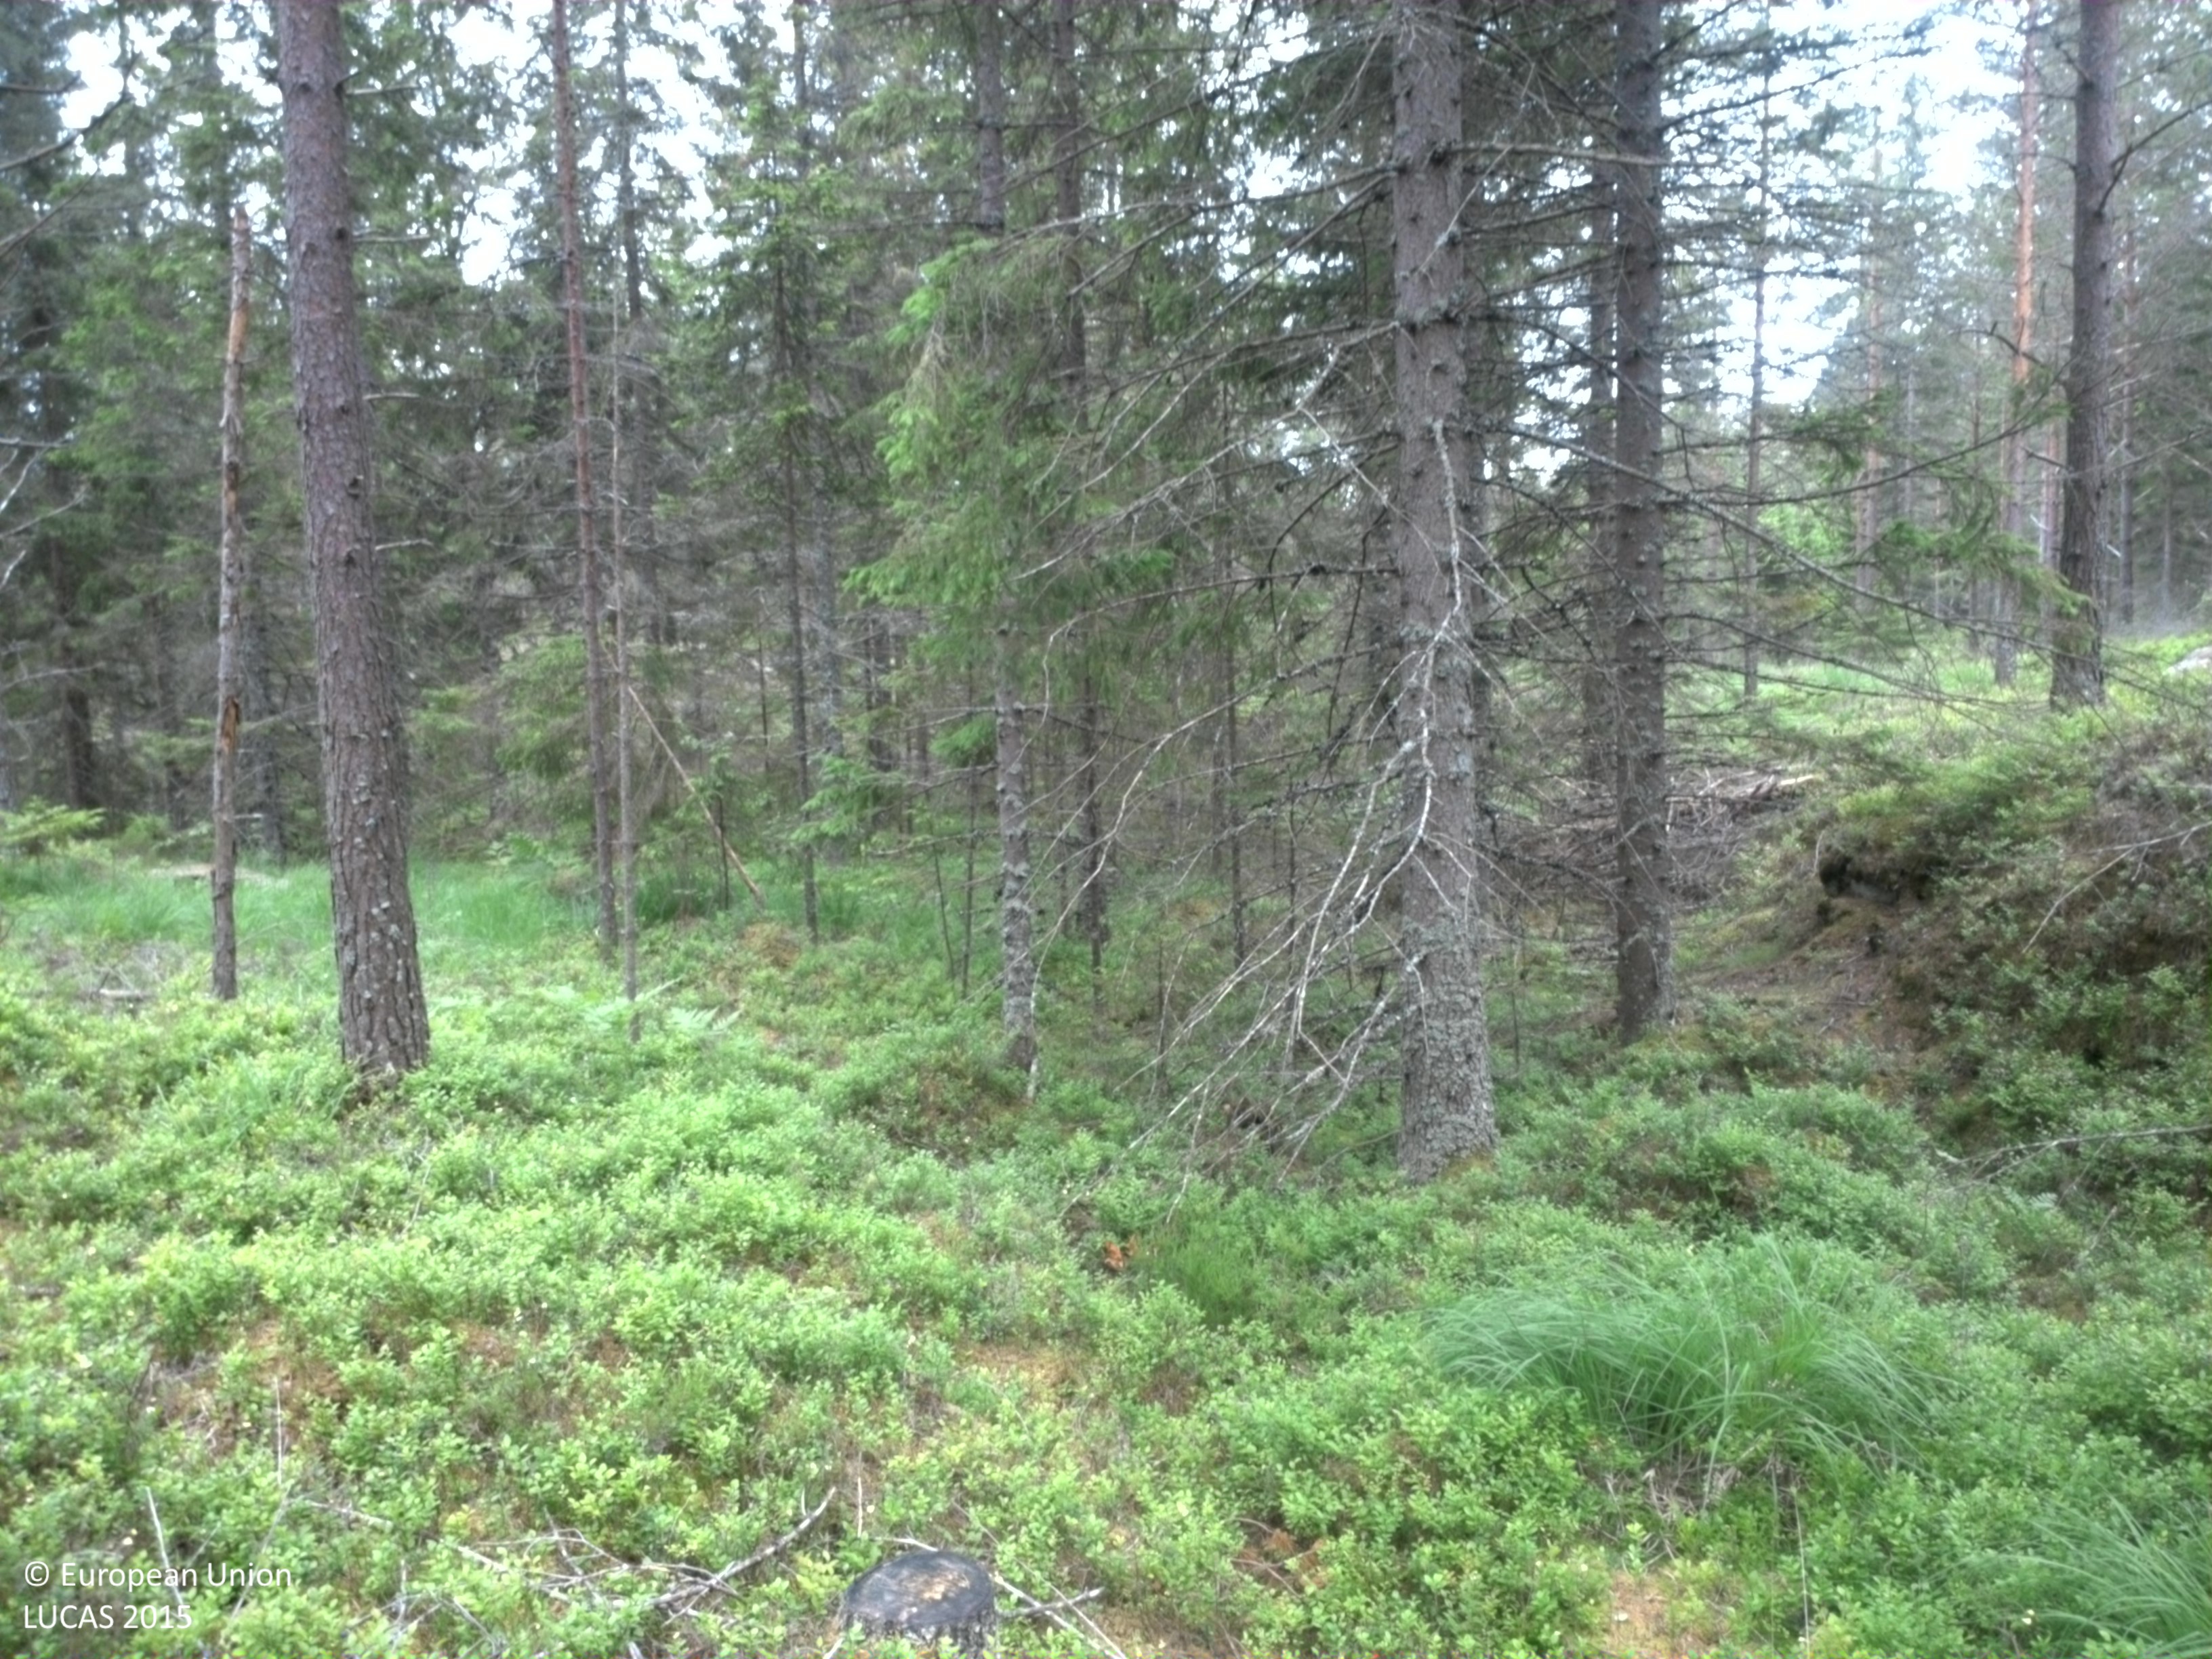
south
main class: Woodland
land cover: Pine dominated coniferous woodland
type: boreal forest
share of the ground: 50 - 75 %
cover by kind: coniferous forest trees 65 %, shrubs 20 %, lichens and mosses 10 %, herbaceous plants 5 %
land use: Forestry
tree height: > 5 m
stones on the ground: < 10 %
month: July
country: SE
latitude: 59.5577
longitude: 11.7470
